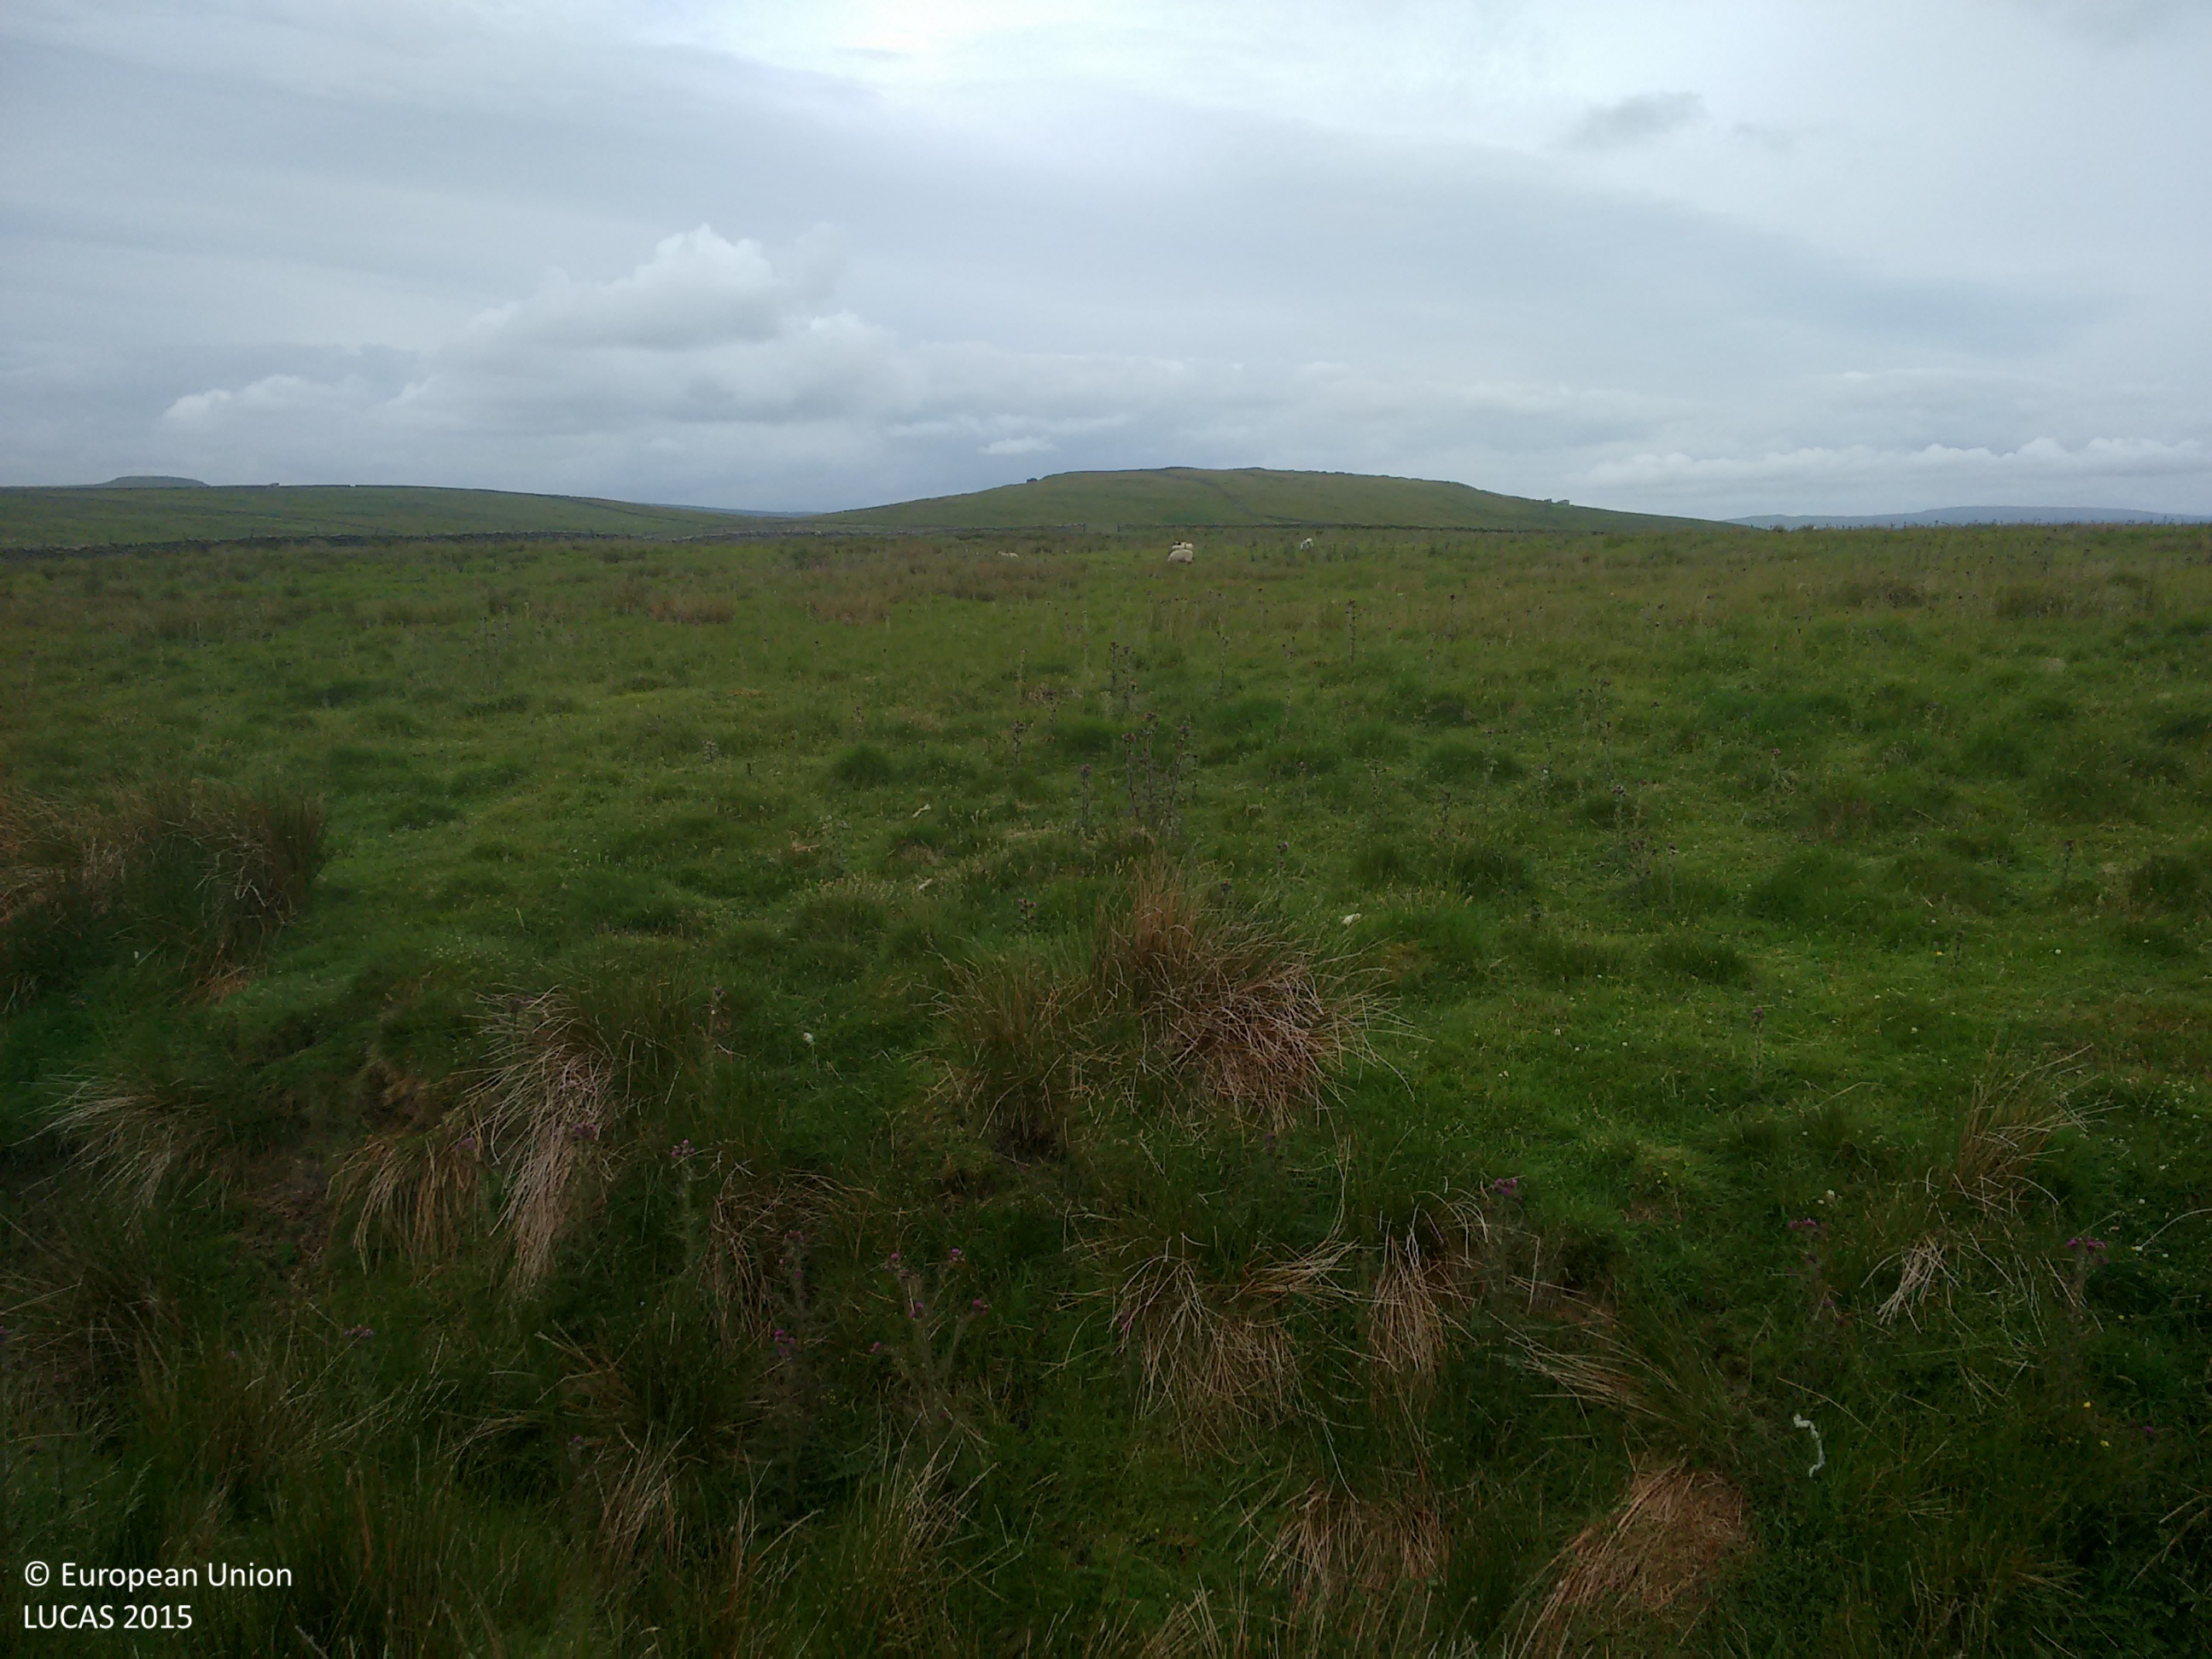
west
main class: Grassland
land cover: Grassland without tree/shrub cover
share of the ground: > 75 %
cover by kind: herbaceous plants 100 %
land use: Agriculture (excluding fallow land and kitchen gardens)
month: July
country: GB
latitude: 54.5745
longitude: -2.1081
